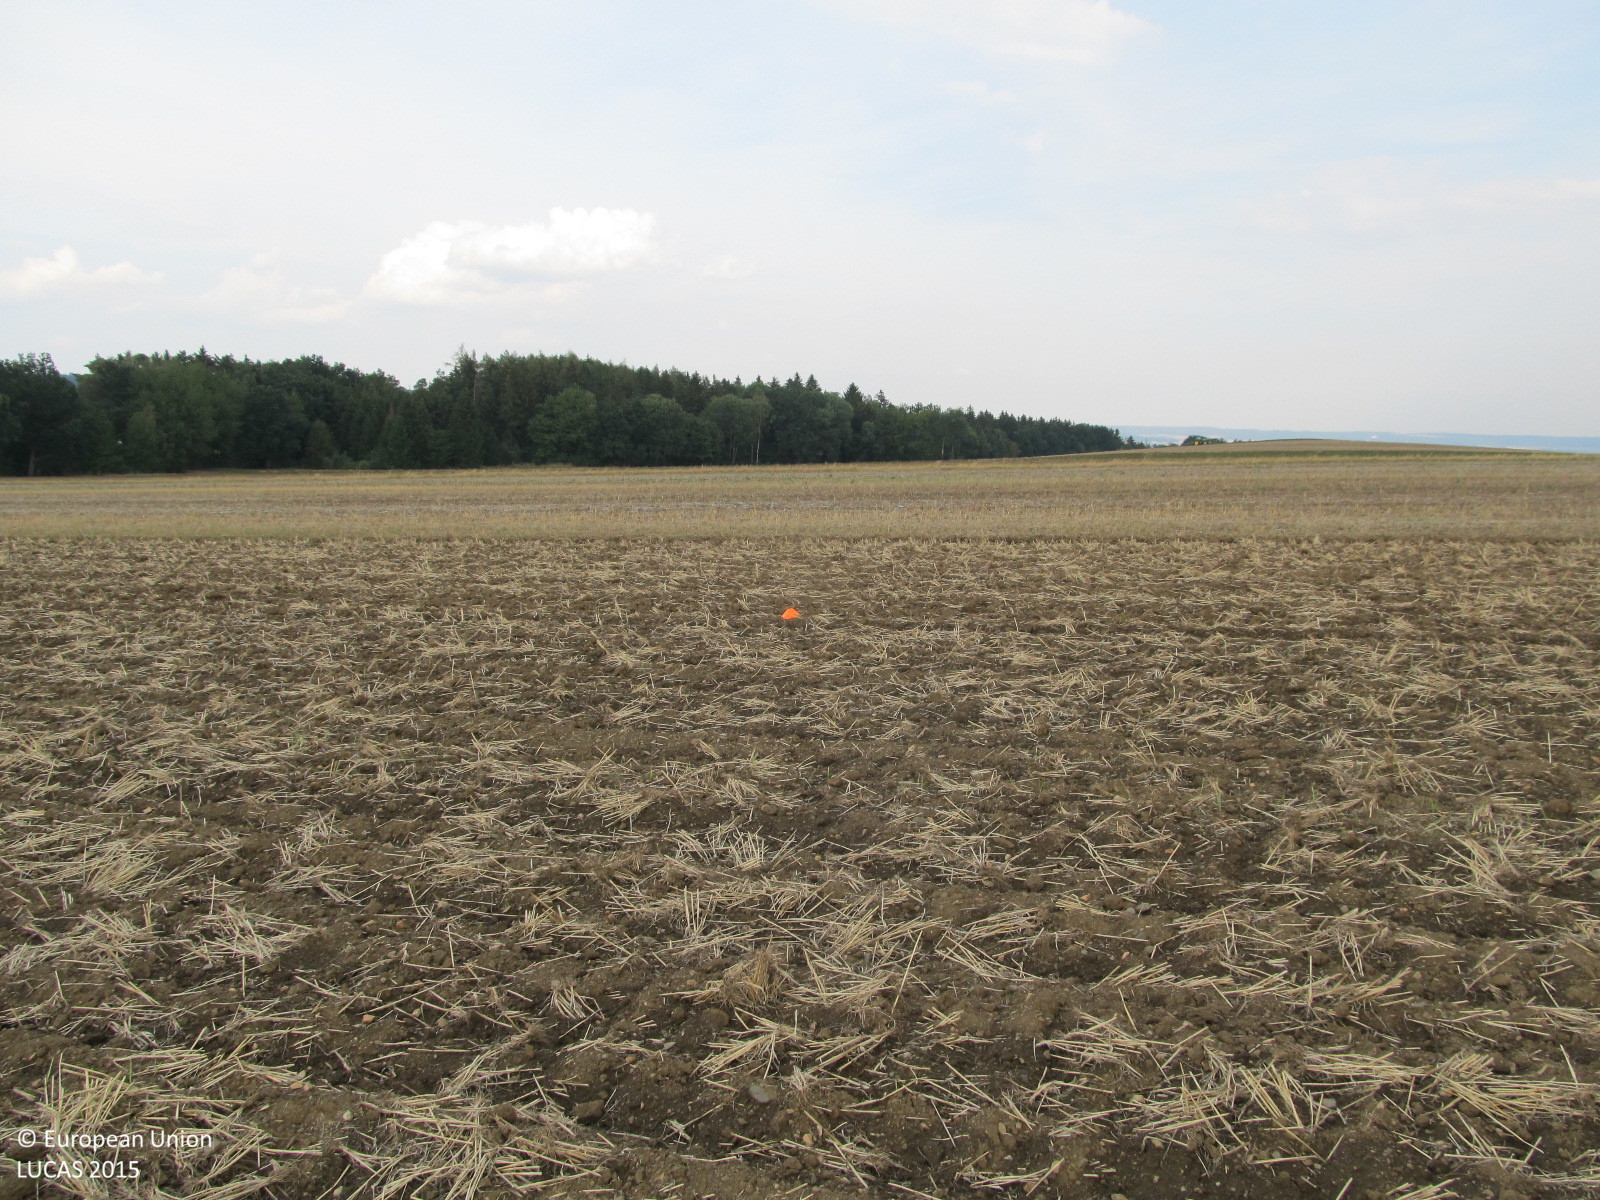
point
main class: Cropland
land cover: Barley
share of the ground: < 10 %
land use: Agriculture (excluding fallow land and kitchen gardens)
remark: Harvested field
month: August
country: AT
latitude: 48.6992
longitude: 15.5058
